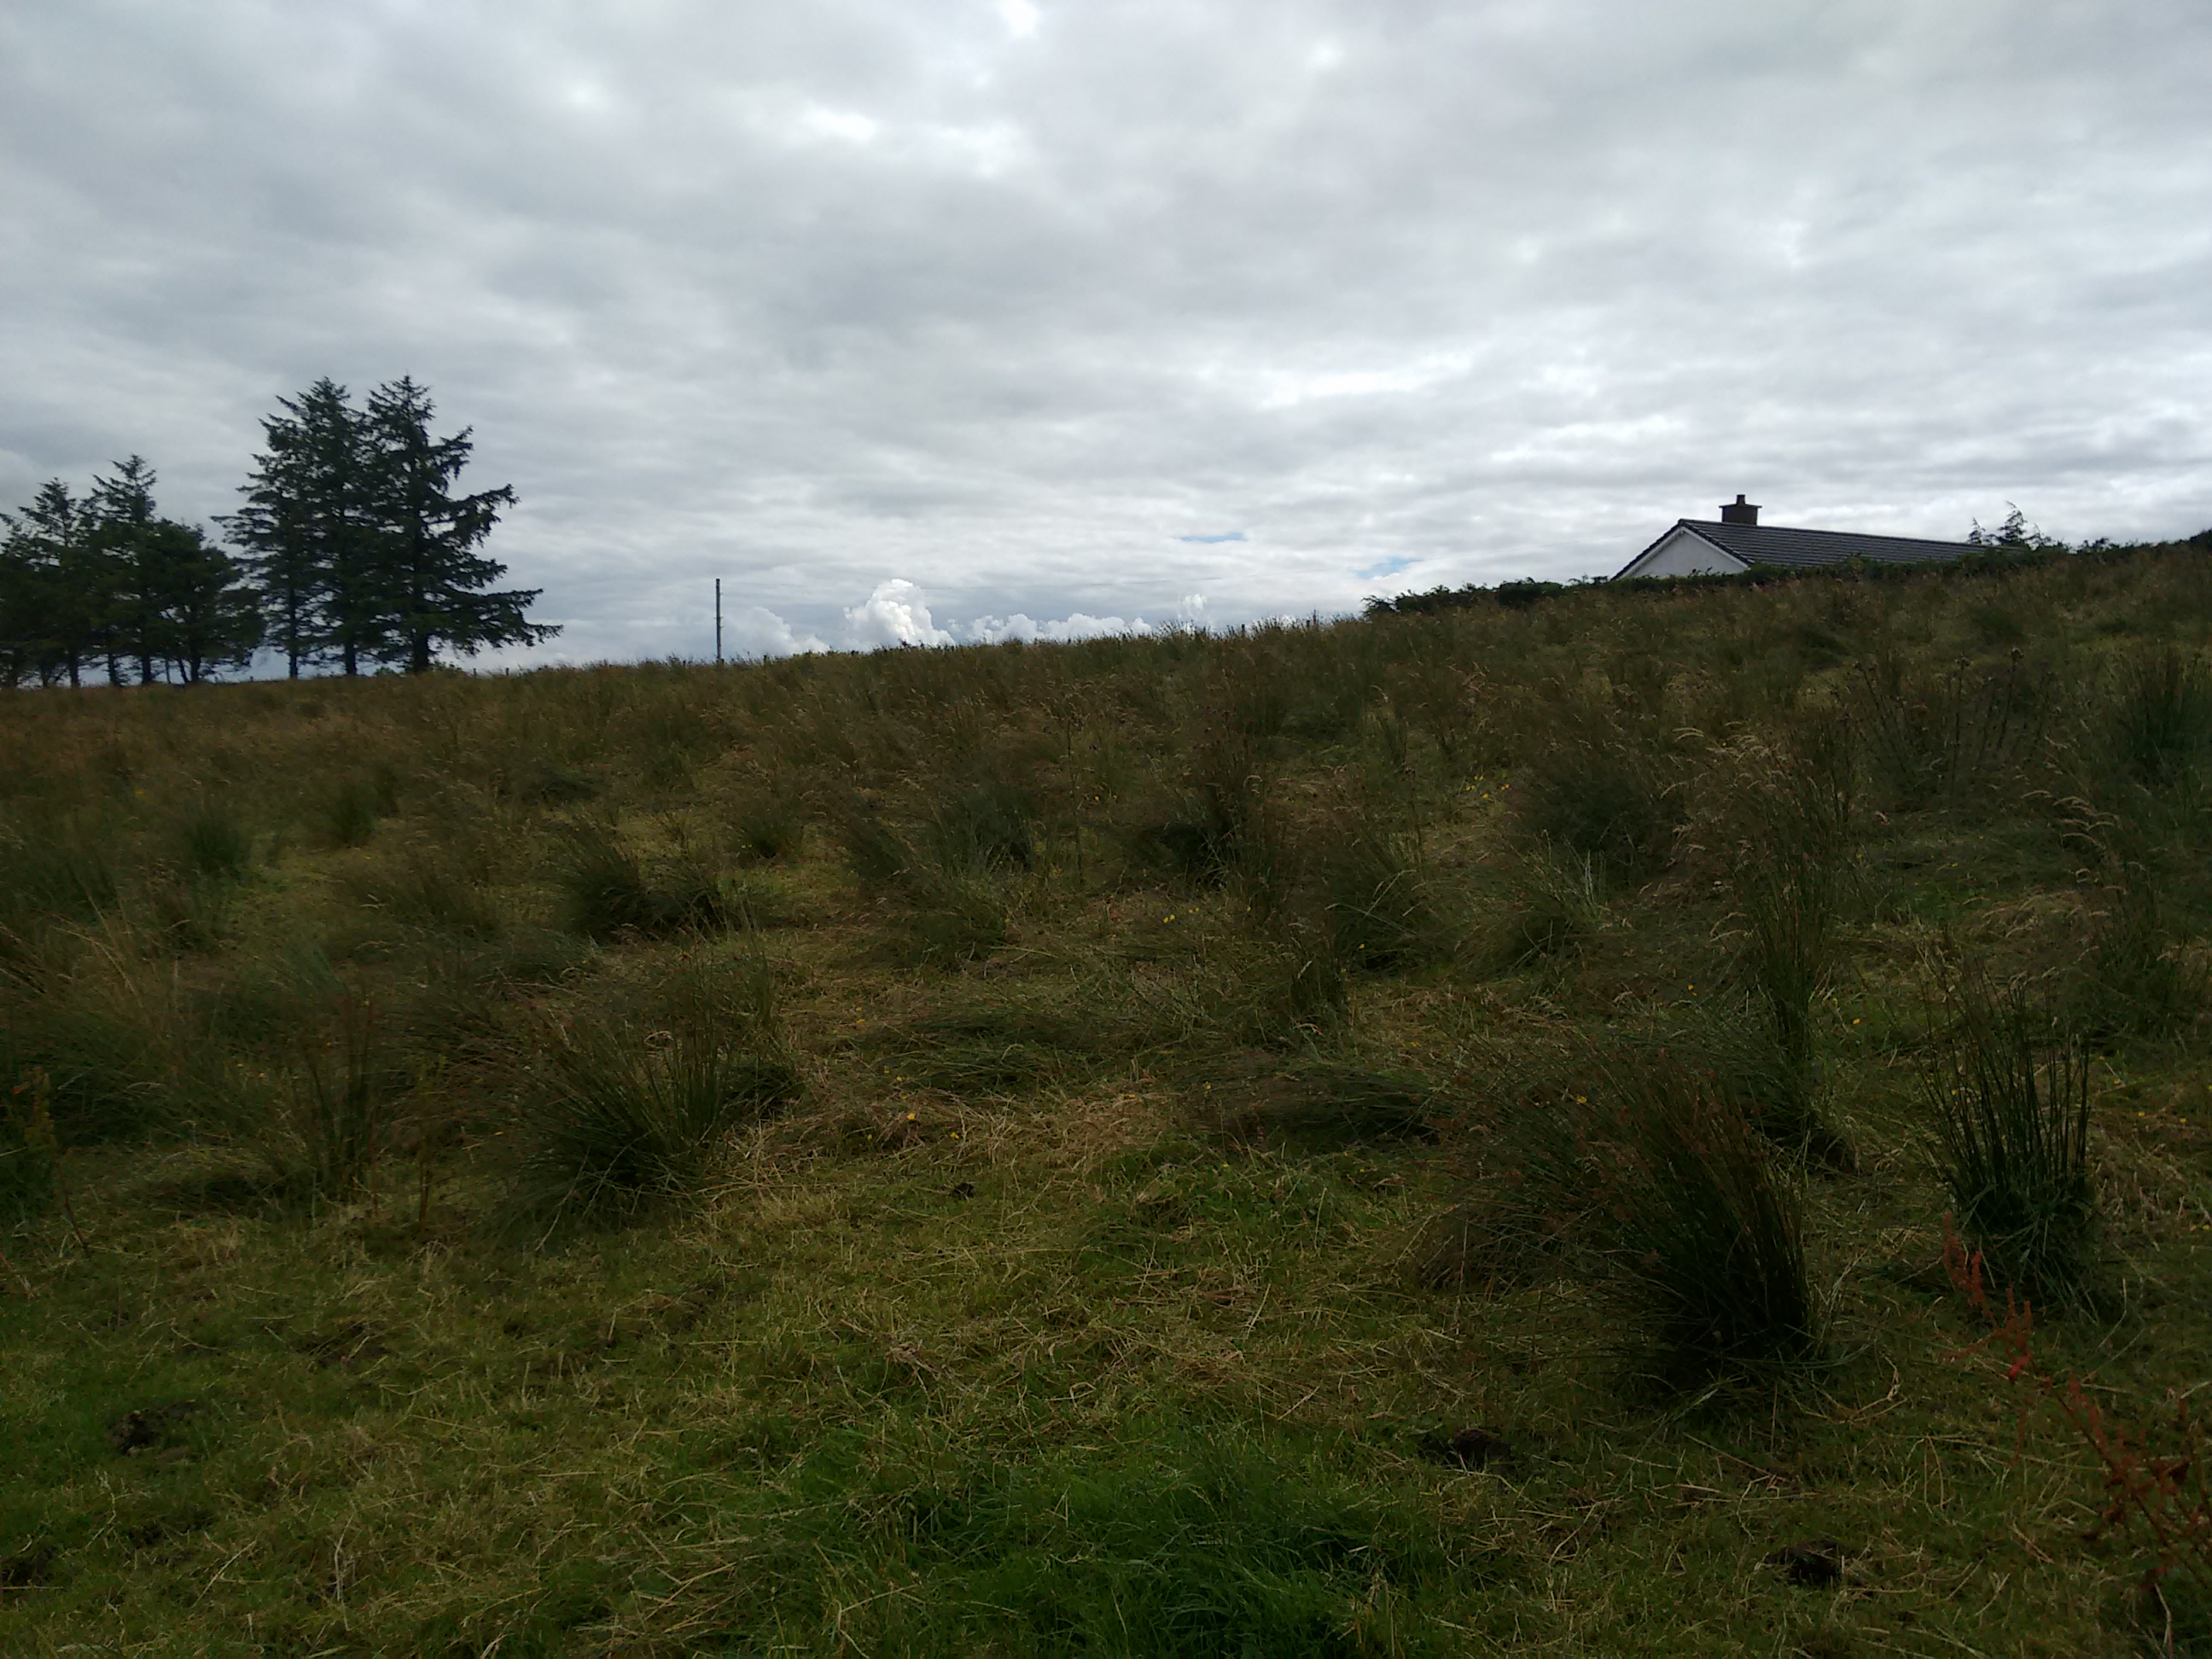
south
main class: Grassland
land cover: Grassland with sparse tree/shrub cover
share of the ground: > 75 %
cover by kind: herbaceous plants 95 %, broadleaved forest trees 5 %
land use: Agriculture (excluding fallow land and kitchen gardens)
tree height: > 5 m
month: August
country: GB
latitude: 54.5335
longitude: -6.9360
